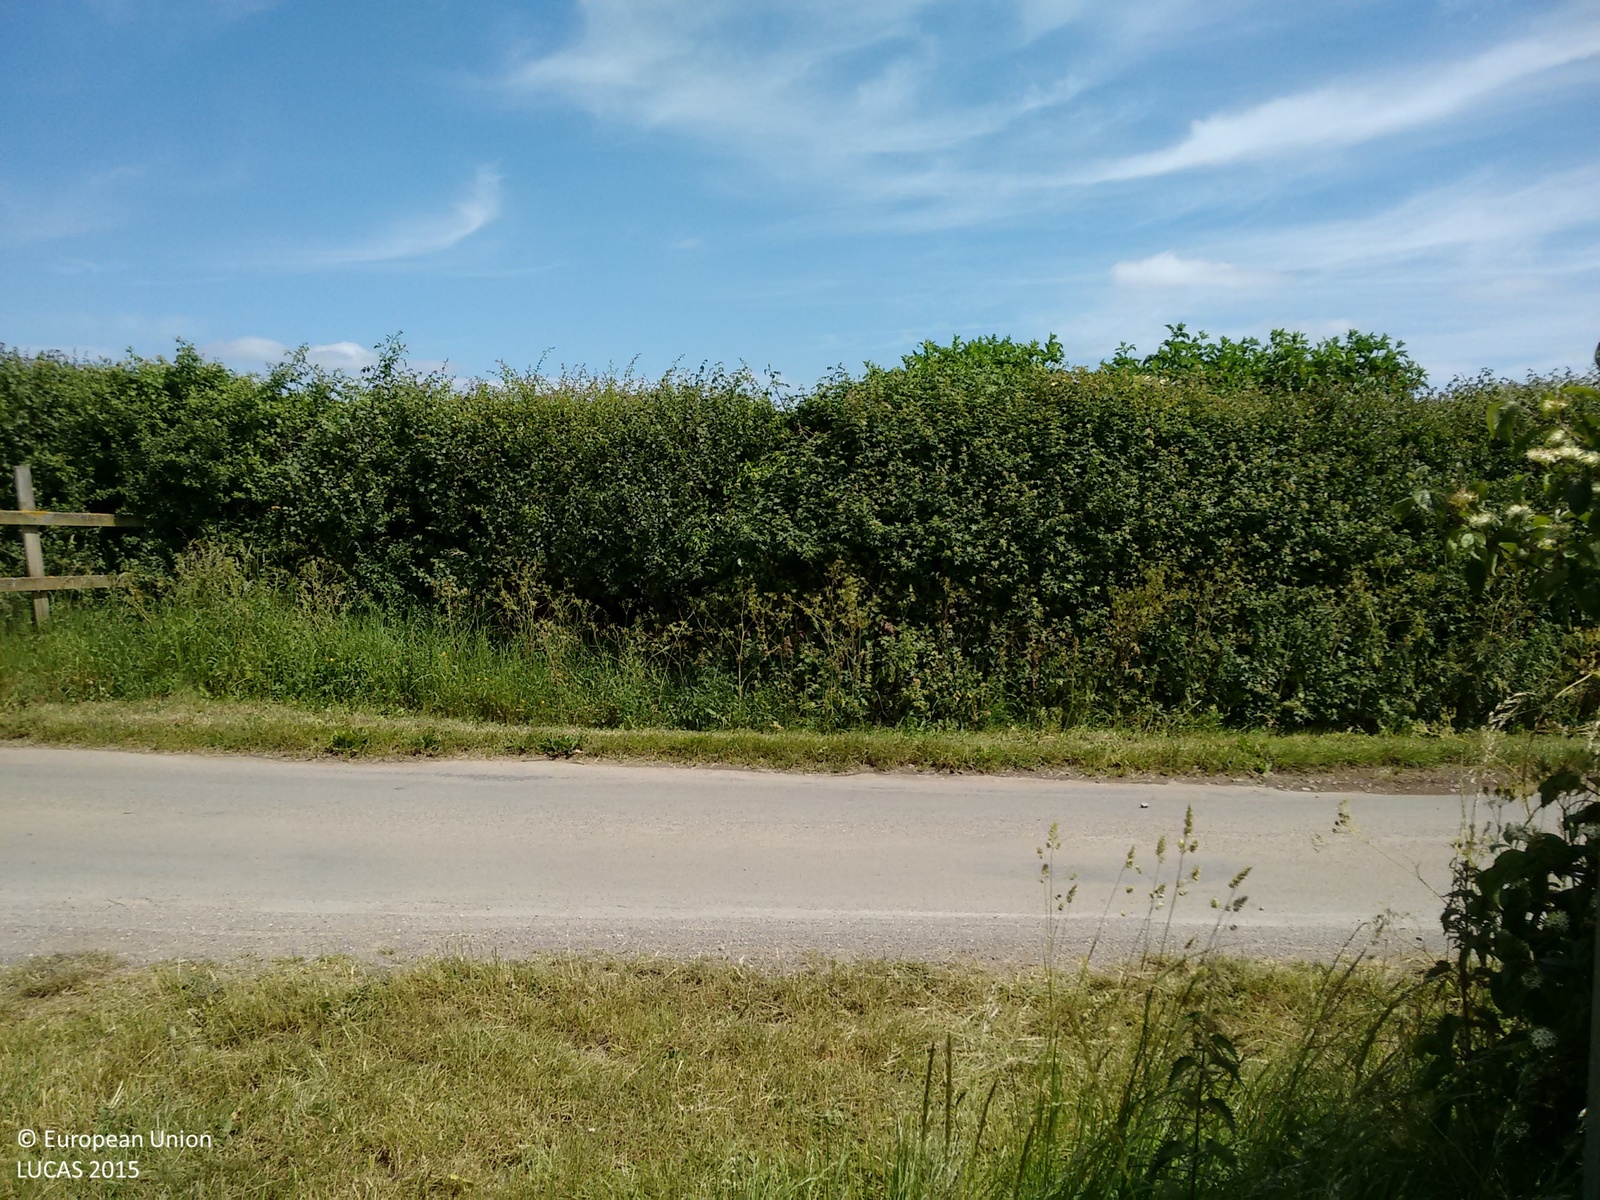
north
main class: Cropland
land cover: Barley
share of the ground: > 75 %
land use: Agriculture (excluding fallow land and kitchen gardens)
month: June
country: GB
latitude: 51.8923
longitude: -1.2805
